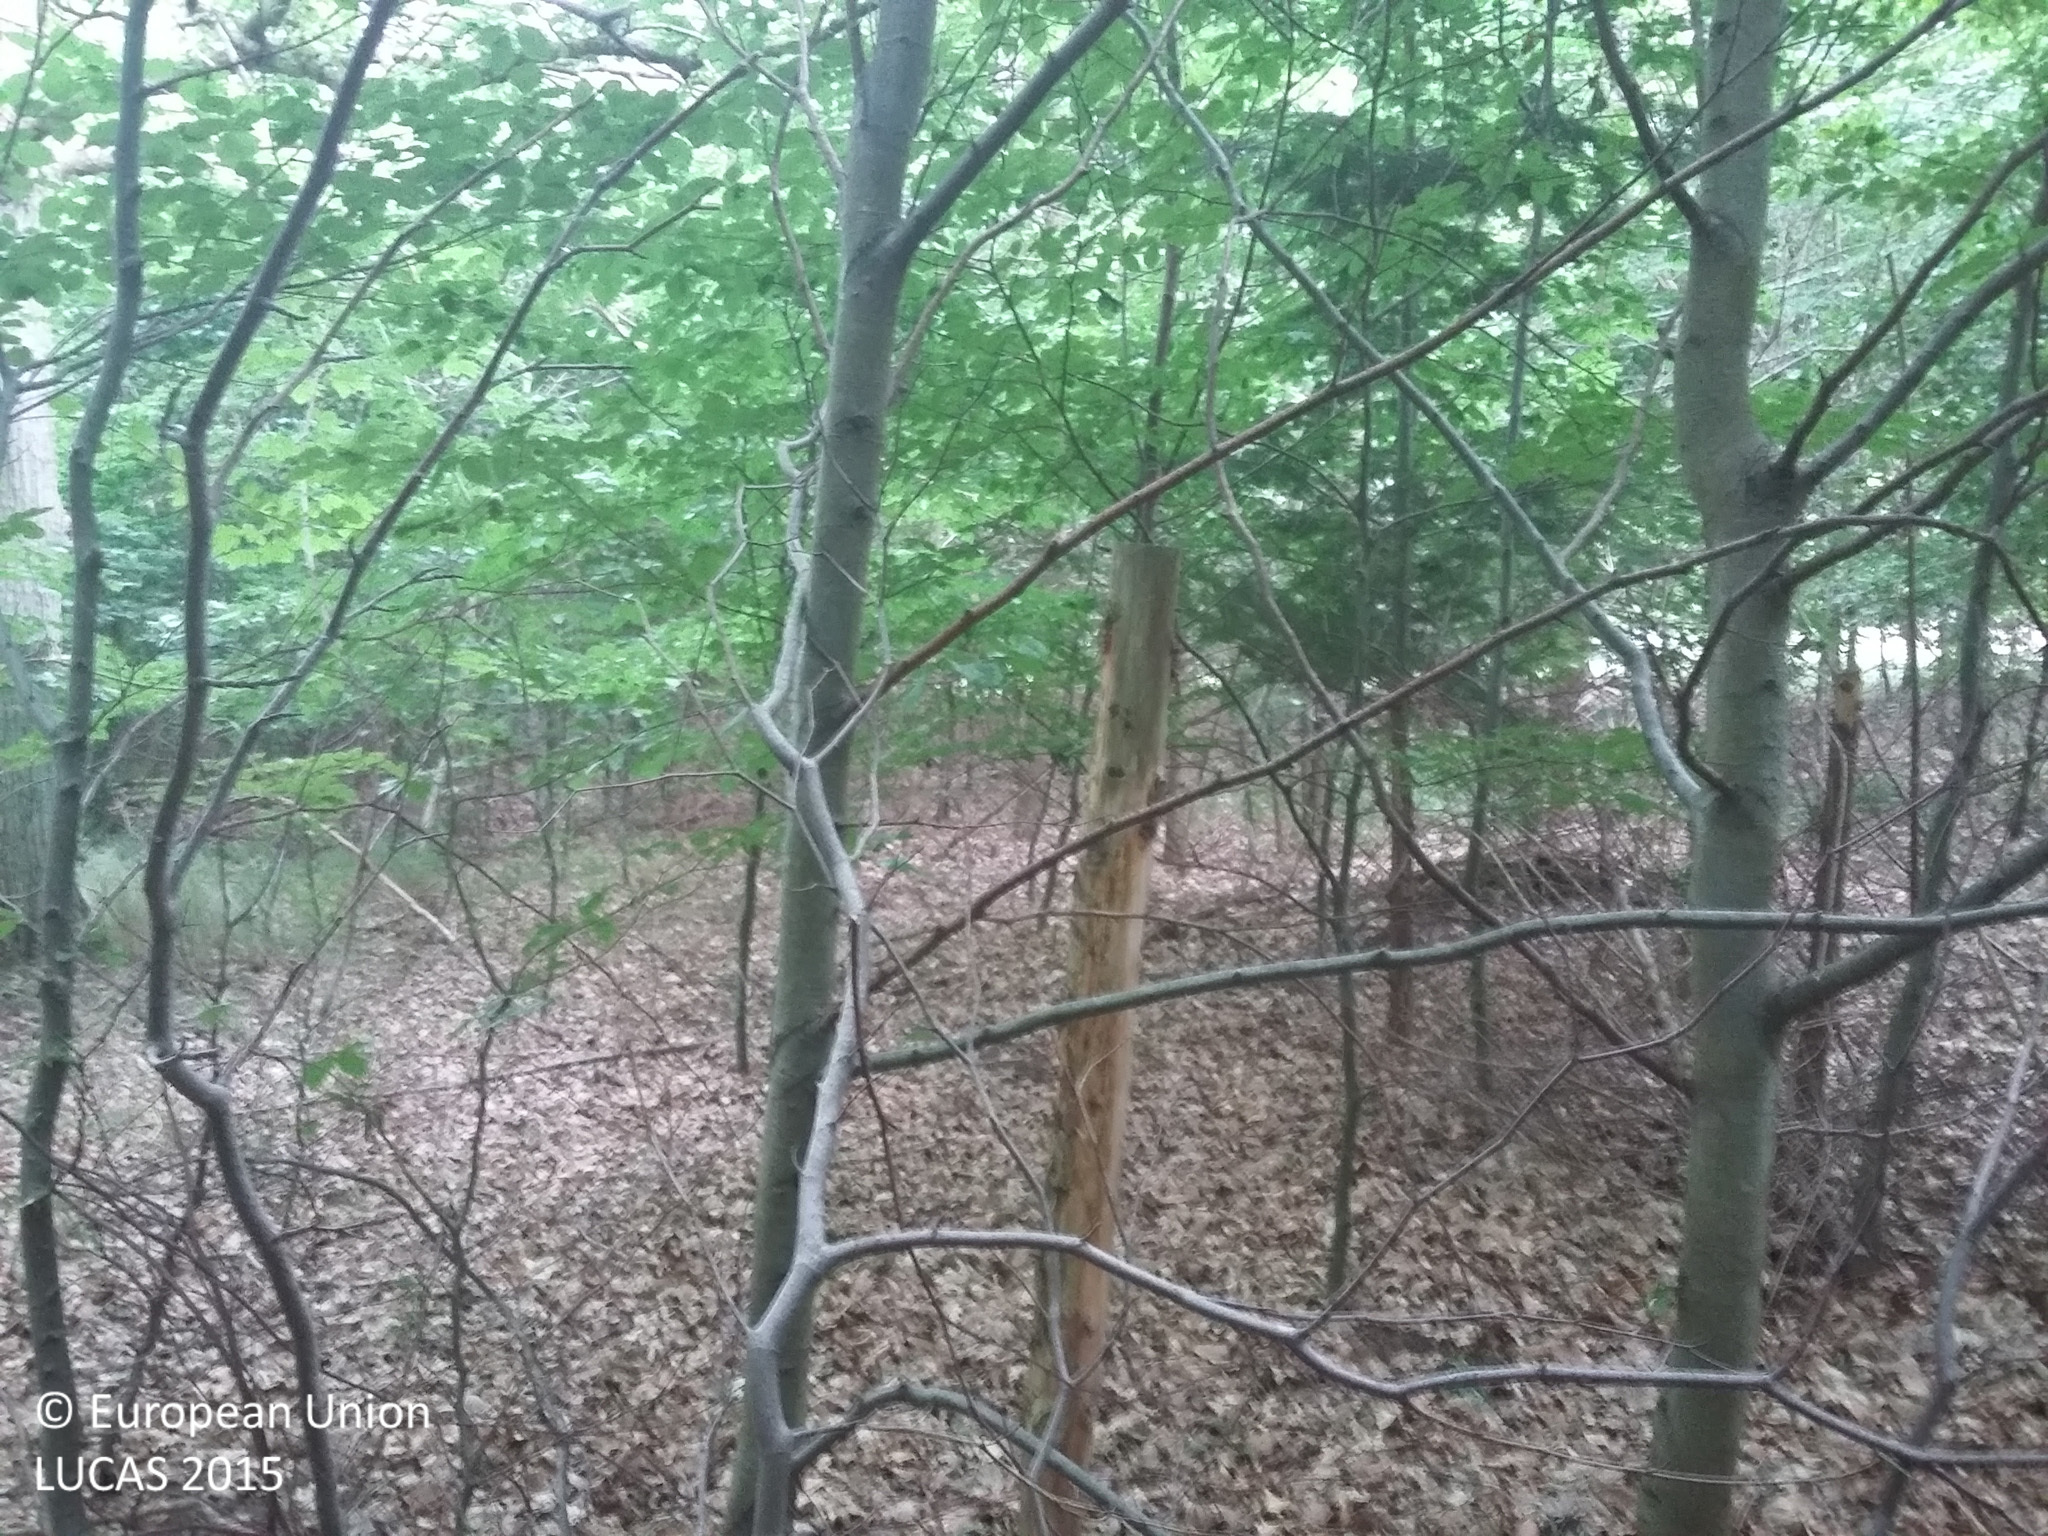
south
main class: Woodland
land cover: Broadleaved woodland
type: beech forest
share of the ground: > 75 %
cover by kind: broadleaved forest trees 95 %, unconsolidated bare surface 5 %
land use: Forestry
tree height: > 5 m
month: July
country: DK
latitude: 55.7398
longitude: 12.0528
